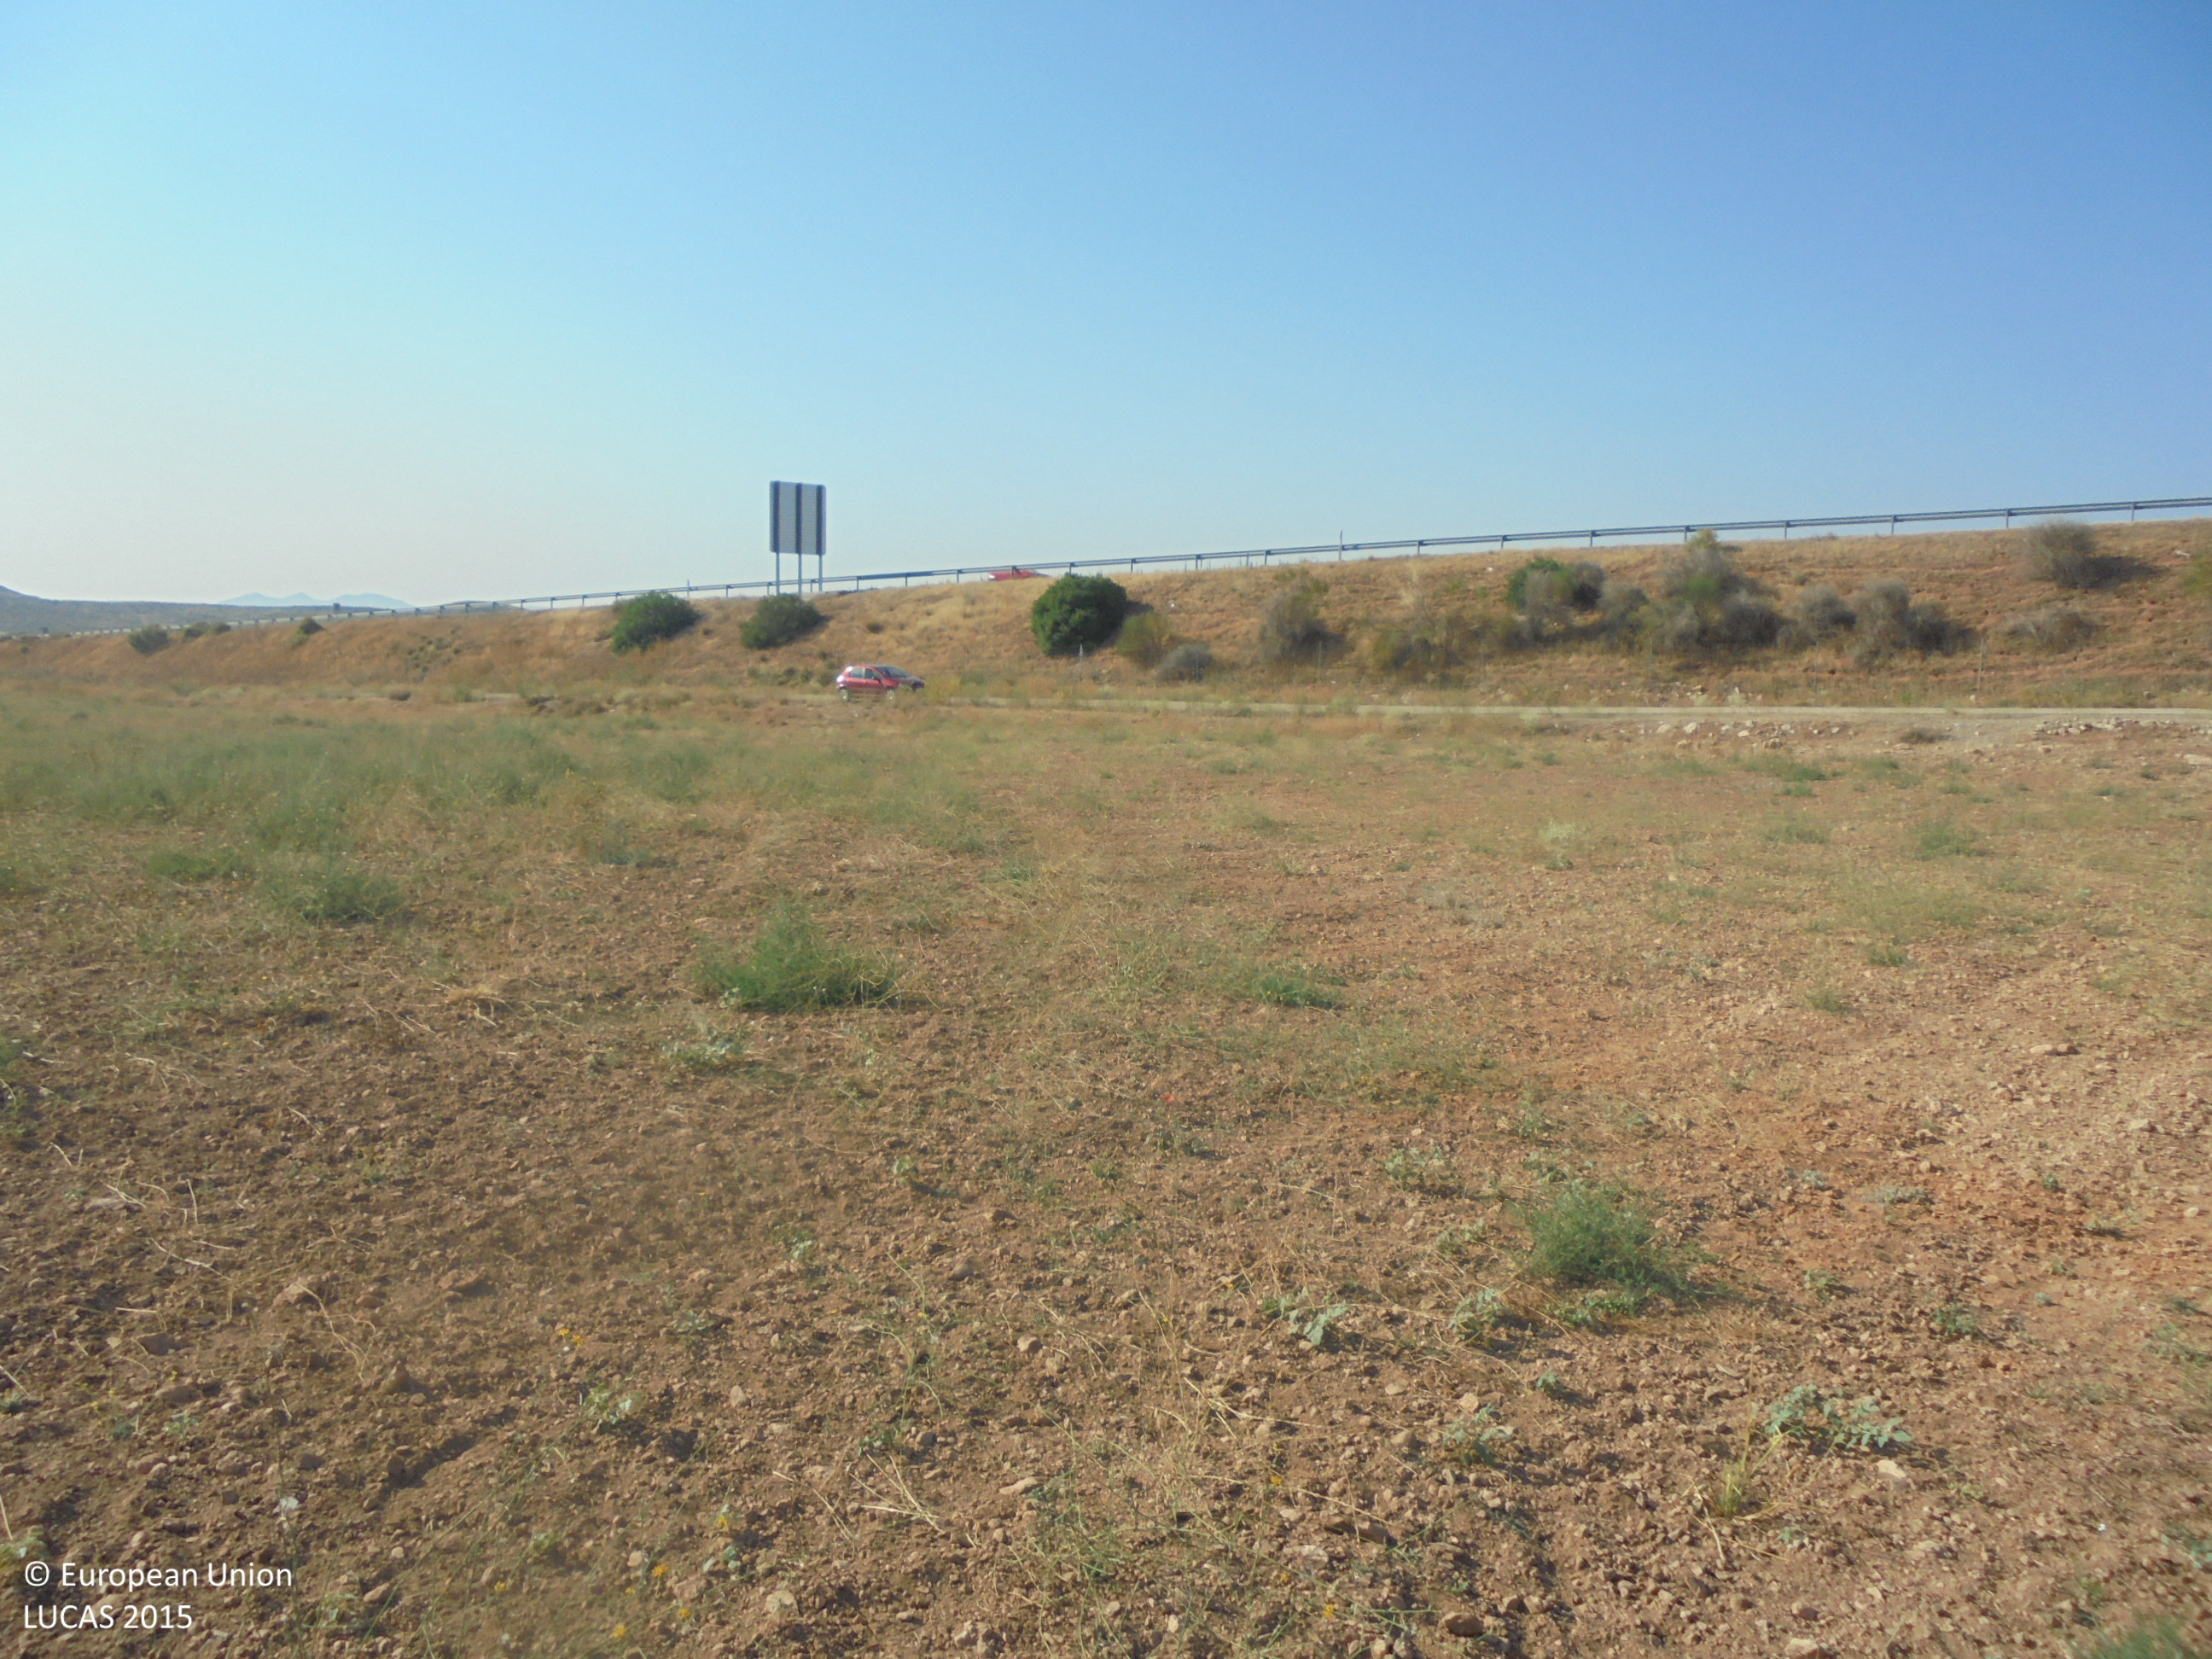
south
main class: Grassland
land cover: Spontaneously vegetated surfaces
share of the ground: 10 - 25 %
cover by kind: unconsolidated bare surface 80 %, herbaceous plants 20 %
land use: Agriculture (excluding fallow land and kitchen gardens)
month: July
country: ES
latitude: 38.5102
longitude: -1.6560
